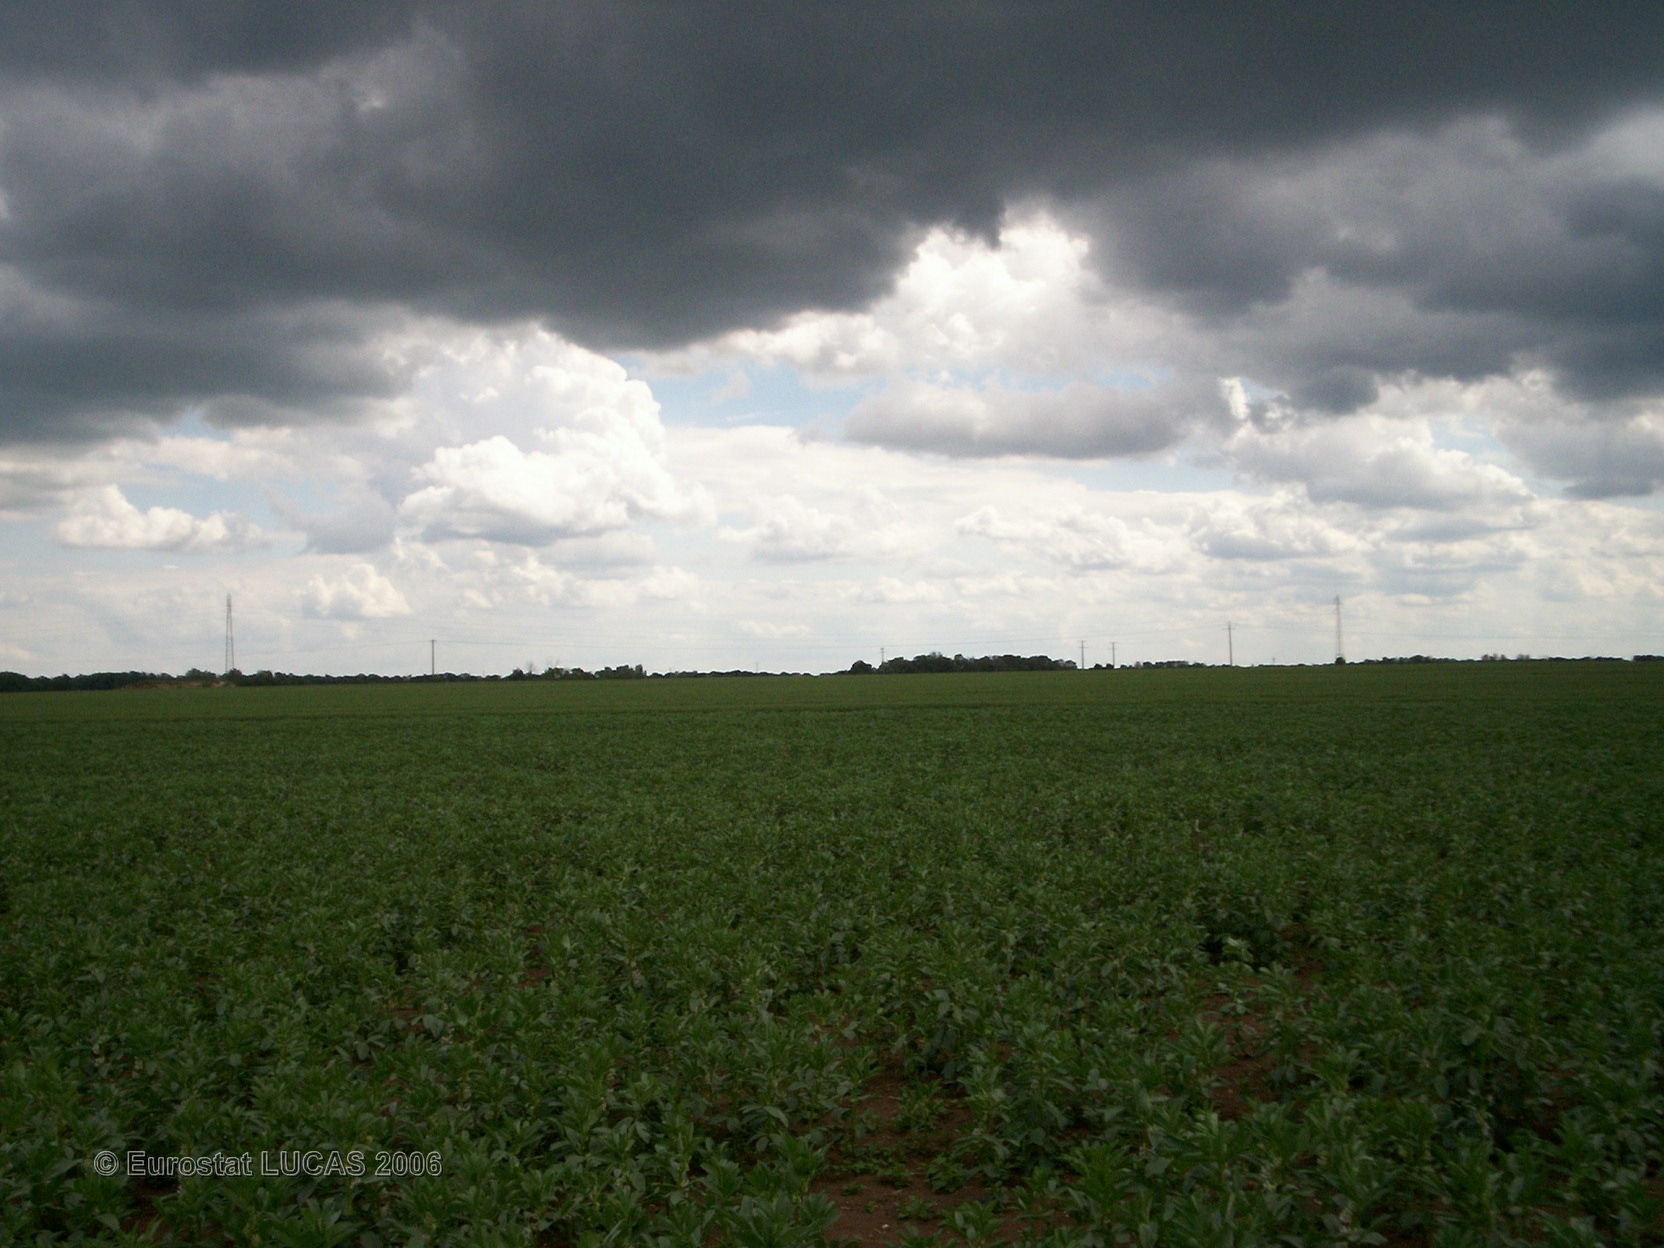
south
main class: Cropland
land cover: Dry pulses
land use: Agriculture (excluding fallow land and kitchen gardens)
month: May
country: FR
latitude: 48.5657
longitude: 2.7951
